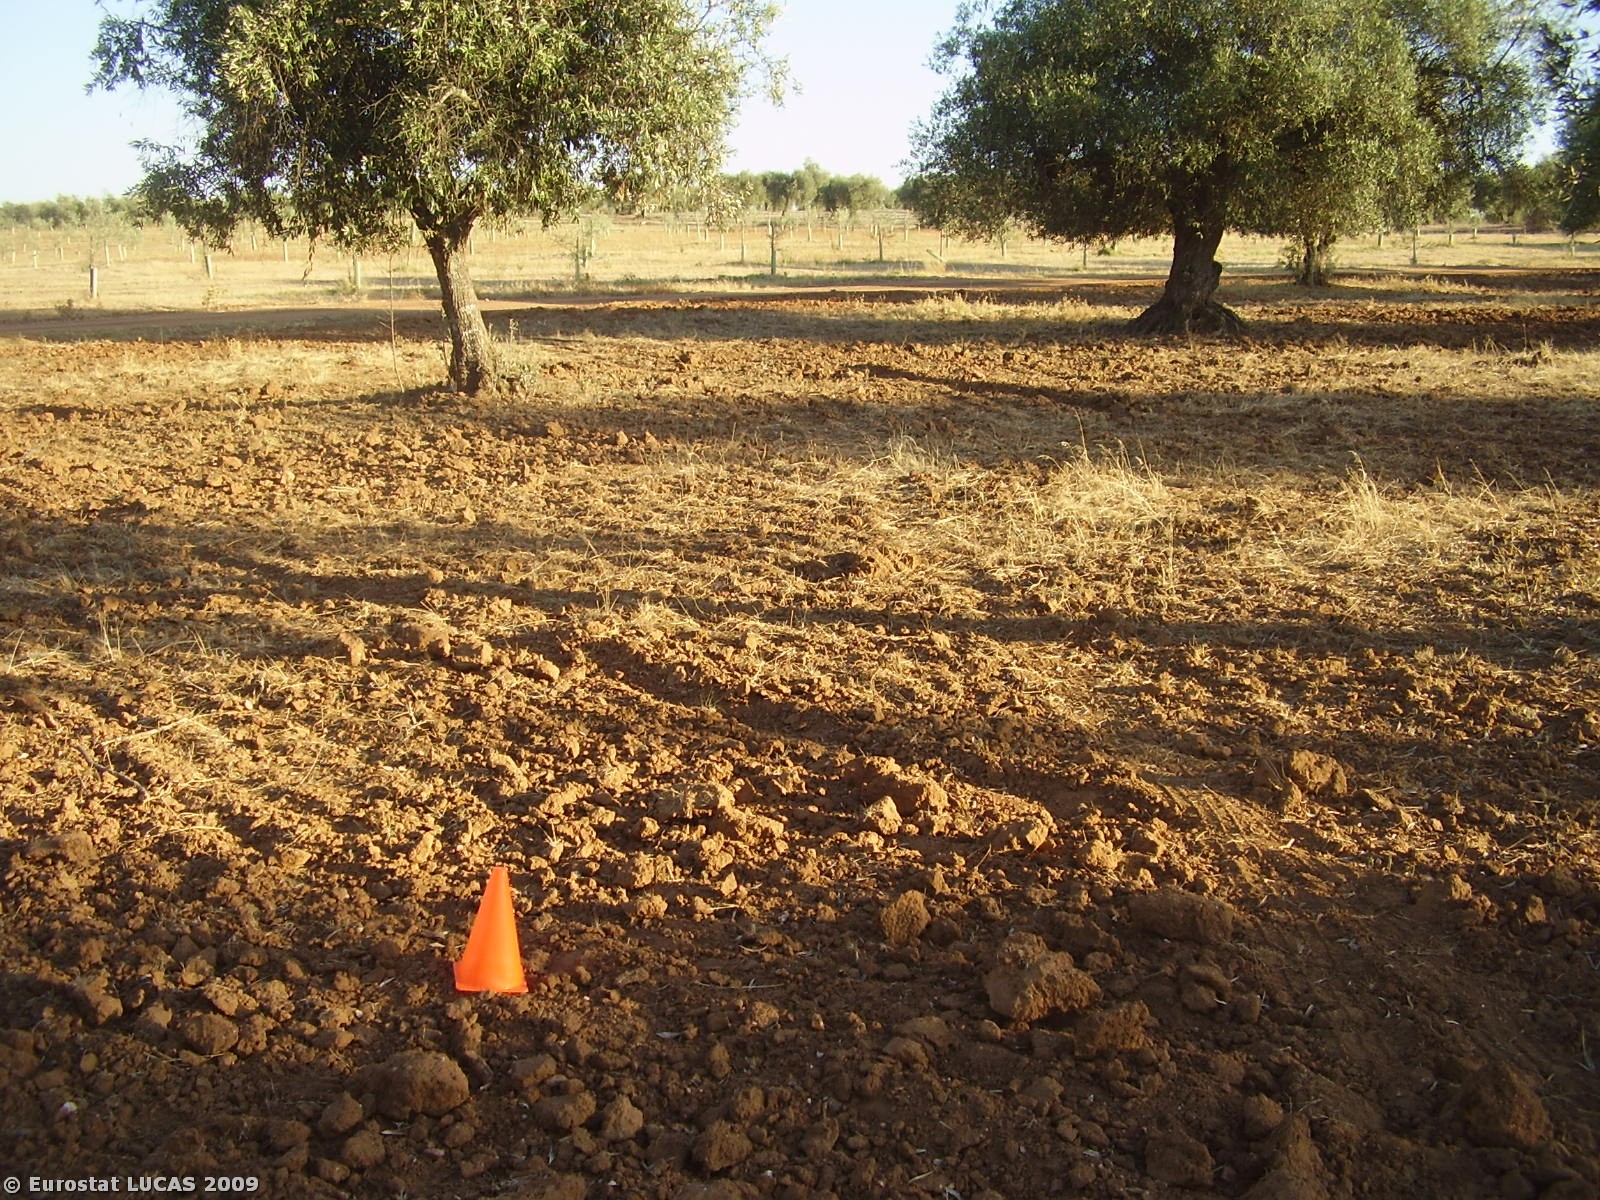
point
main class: Cropland
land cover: Olive groves
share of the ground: 10 - 25 %
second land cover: Spontaneously vegetated surfaces
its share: 10 - 25 %
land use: Agriculture (excluding fallow land and kitchen gardens)
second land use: Fallow land
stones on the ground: 25 - 50 %
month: August
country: PT
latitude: 38.0419
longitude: -7.5573
